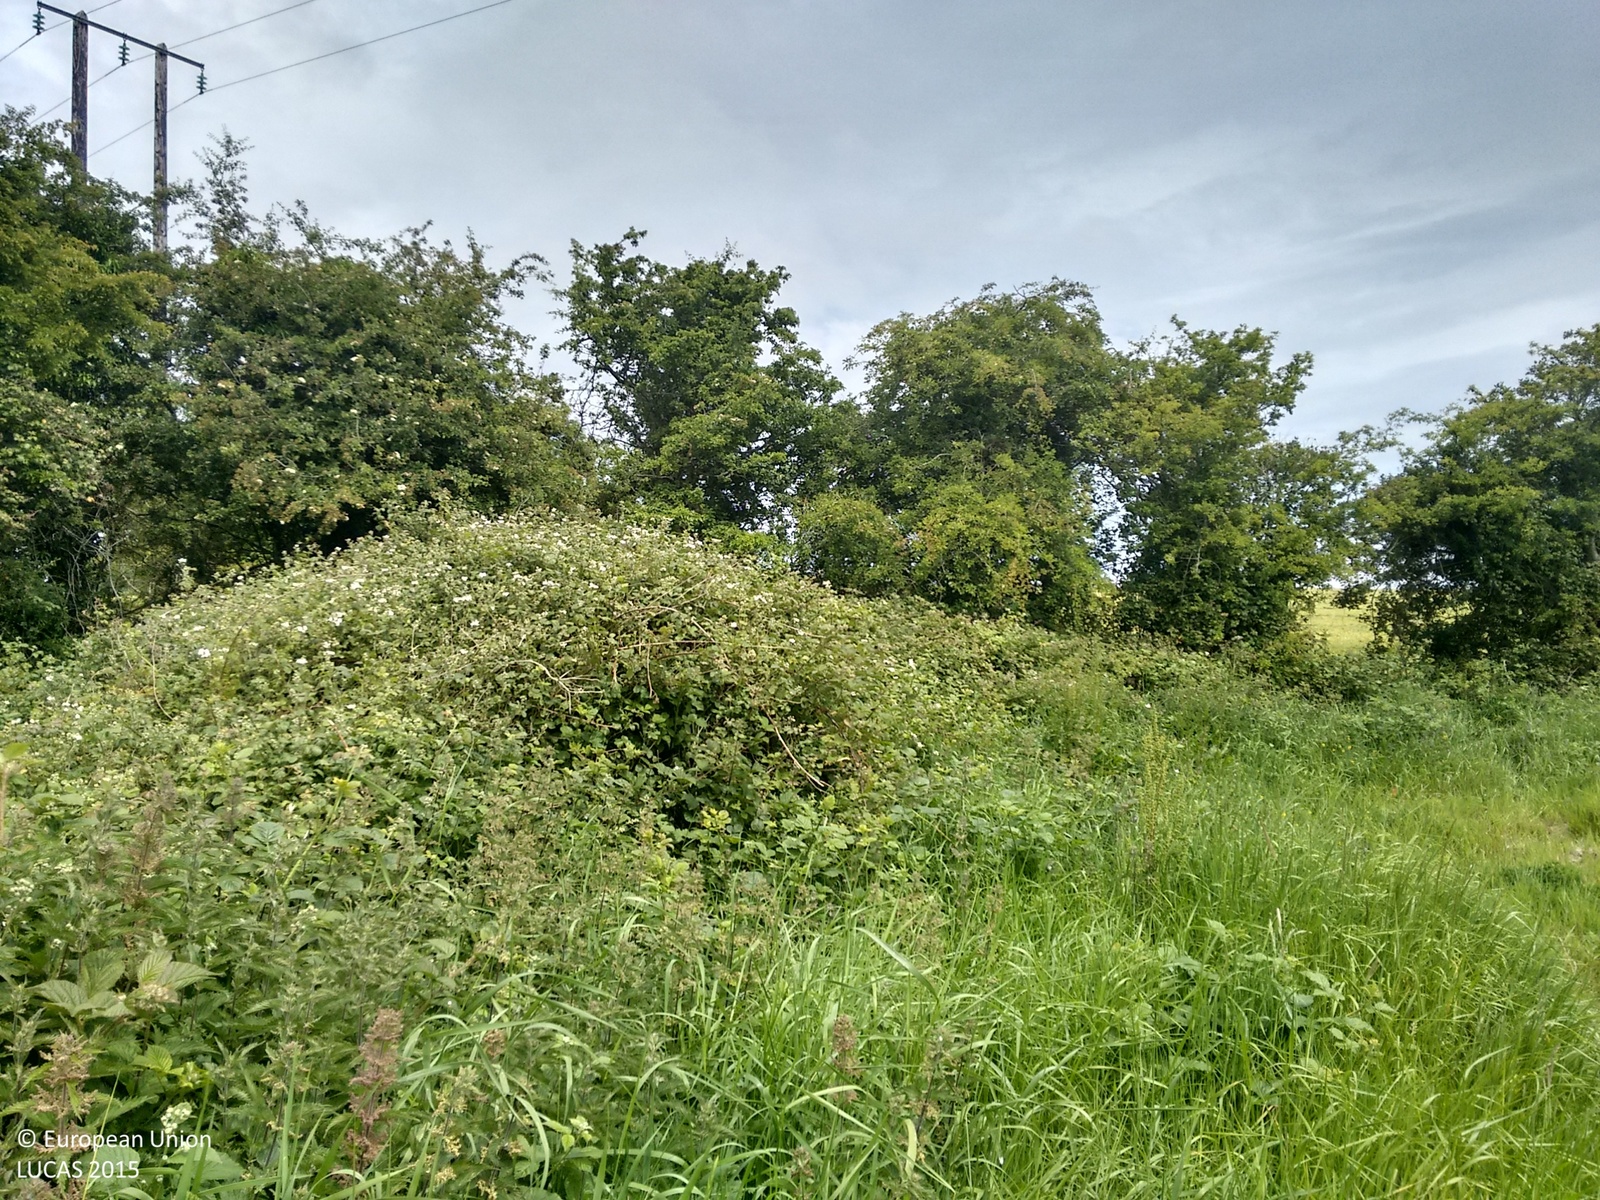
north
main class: Cropland
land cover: Other fresh vegetables
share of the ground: > 75 %
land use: Agriculture (excluding fallow land and kitchen gardens)
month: June
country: IE
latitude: 53.5718
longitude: -6.1693
